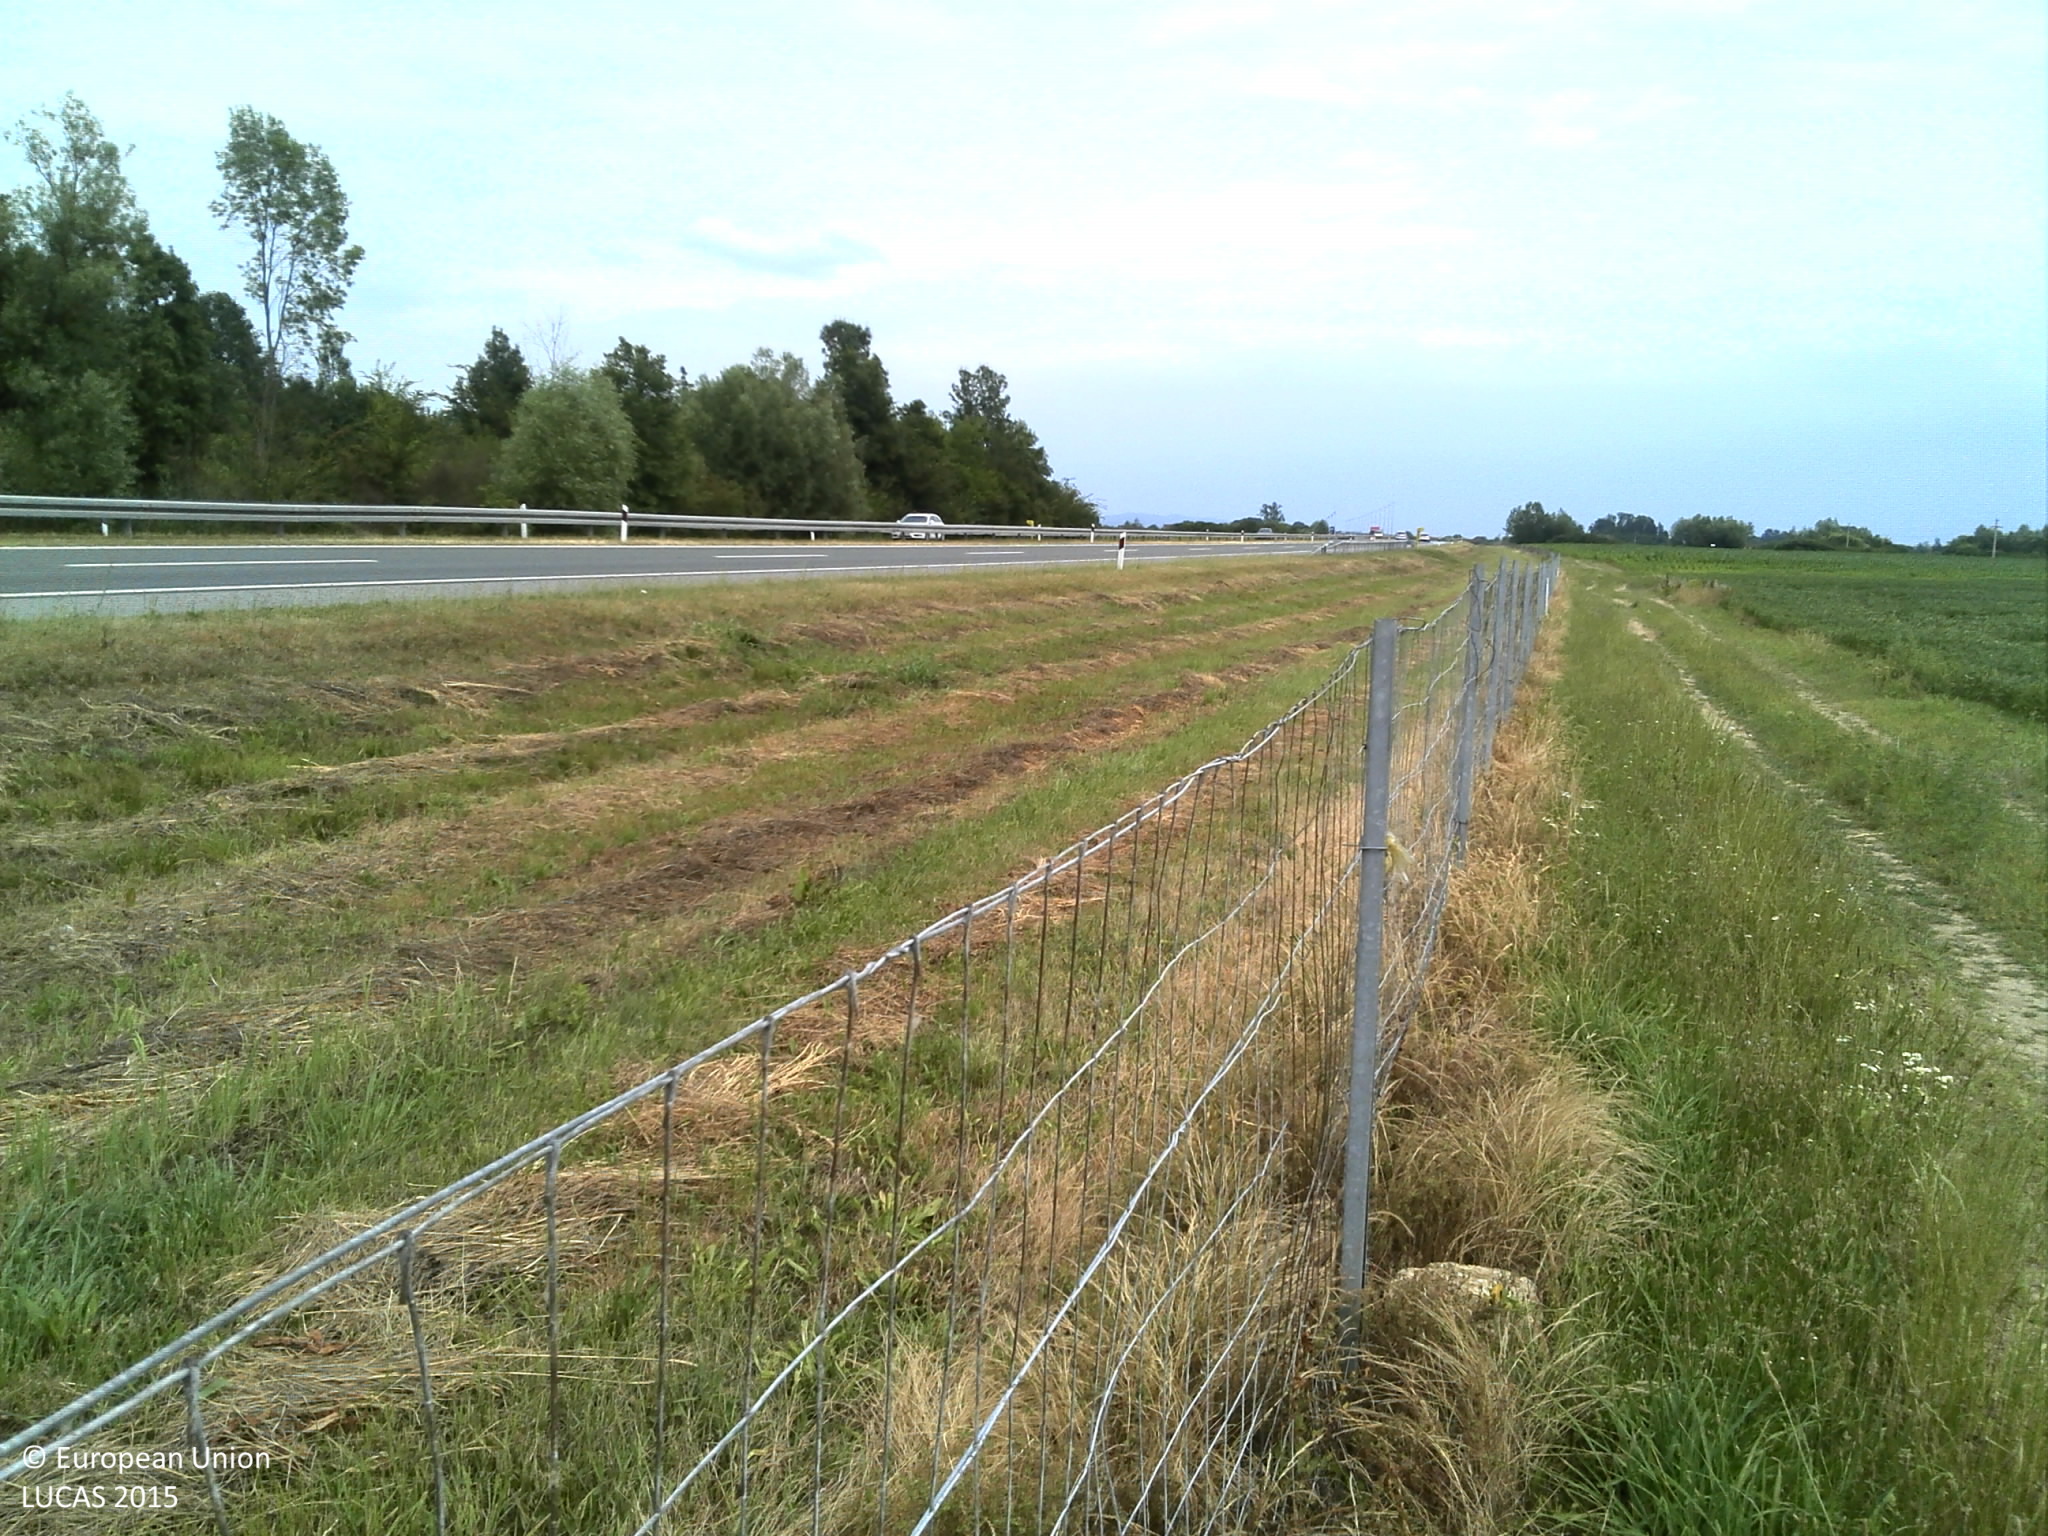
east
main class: Grassland
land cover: Spontaneously vegetated surfaces
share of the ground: > 75 %
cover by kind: herbaceous plants 95 %, lichens and mosses 5 %
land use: Semi-natural and natural areas not in use
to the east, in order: Spontaneously vegetated surfaces; Ditches and canals; Artificial constructions in urban areas; Spontaneously vegetated surfaces; Broadleaved woodland
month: June
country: HR
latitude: 45.2193
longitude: 17.5011
